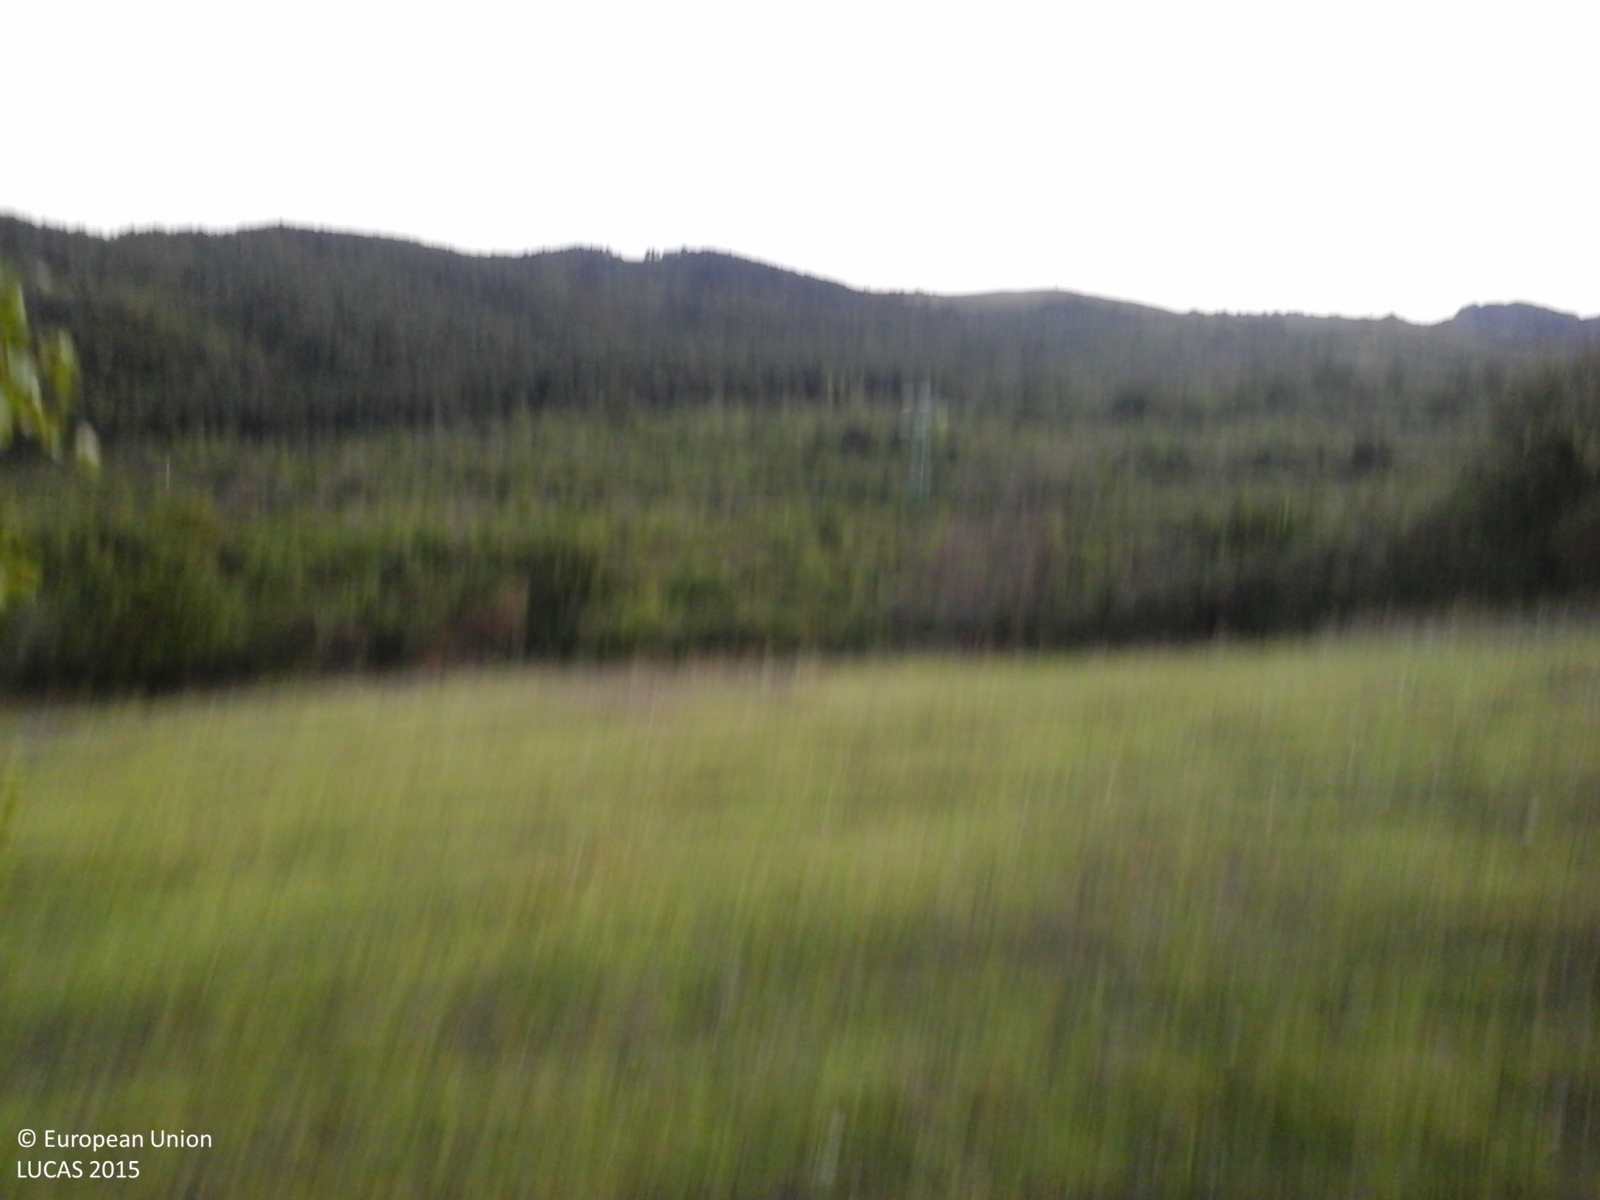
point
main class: Shrubland
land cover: Shrubland with sparse tree cover
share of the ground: > 75 %
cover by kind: shrubs 80 %, herbaceous plants 10 %, broadleaved forest trees 5 %, unconsolidated bare surface 5 %
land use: Semi-natural and natural areas not in use
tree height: < 5 m
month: August
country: IT
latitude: 42.8224
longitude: 11.5728
